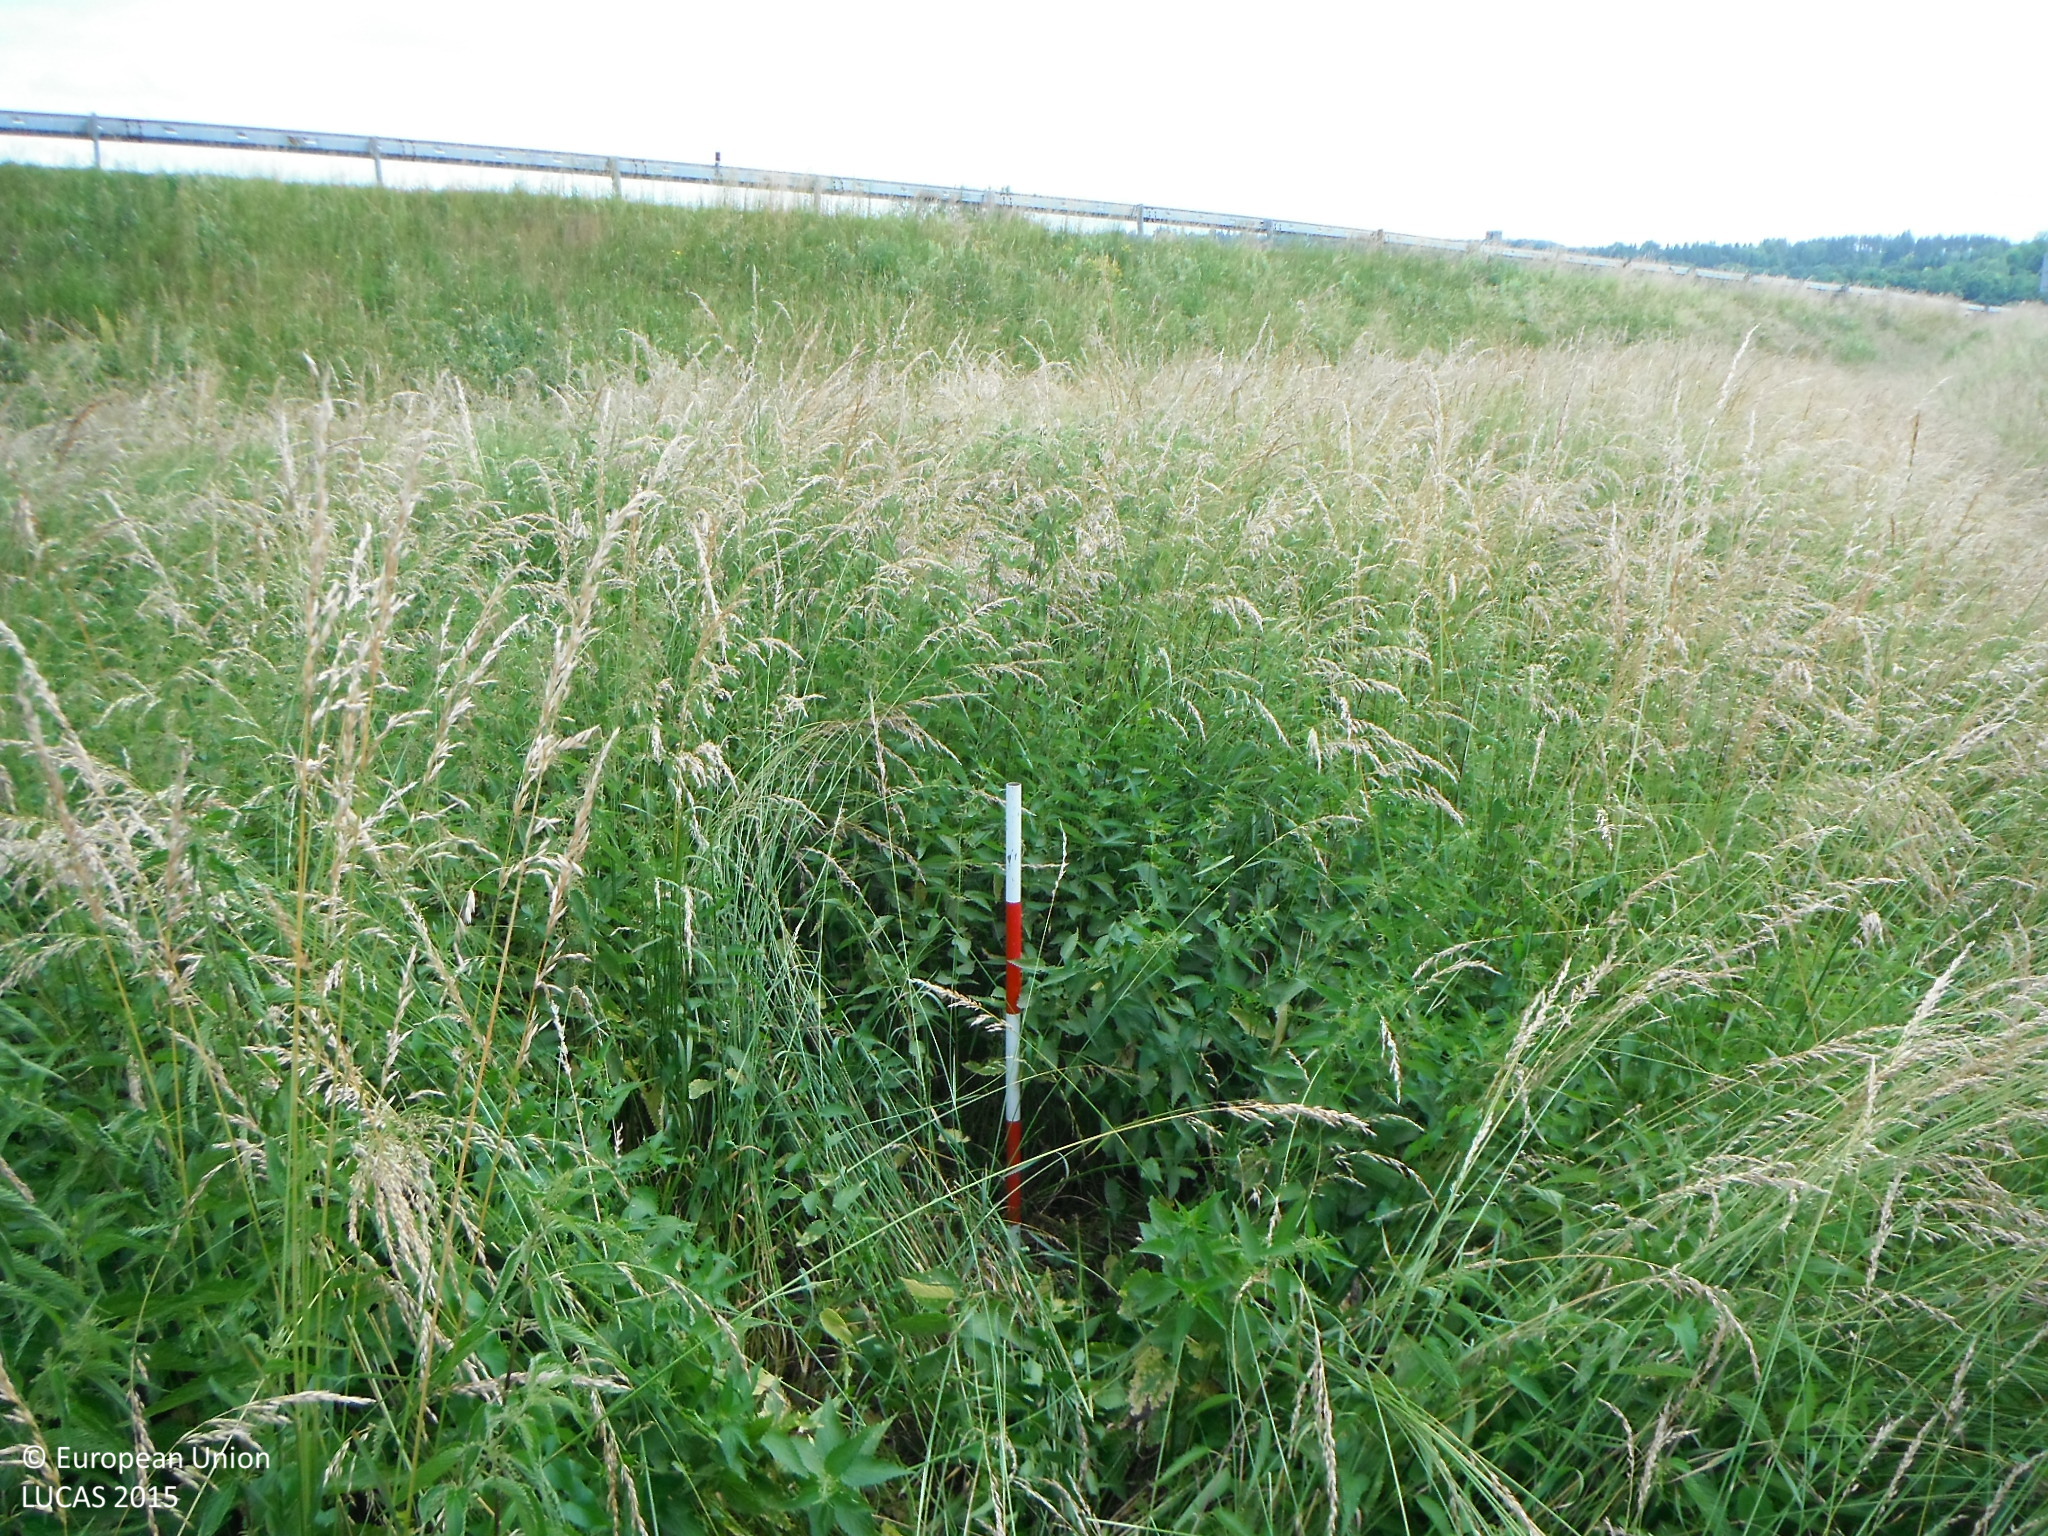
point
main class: Grassland
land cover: Grassland without tree/shrub cover
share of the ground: > 75 %
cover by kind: herbaceous plants 100 %
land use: Protection infrastructures
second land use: Road transport
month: June
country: SK
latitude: 48.6052
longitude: 19.1218
